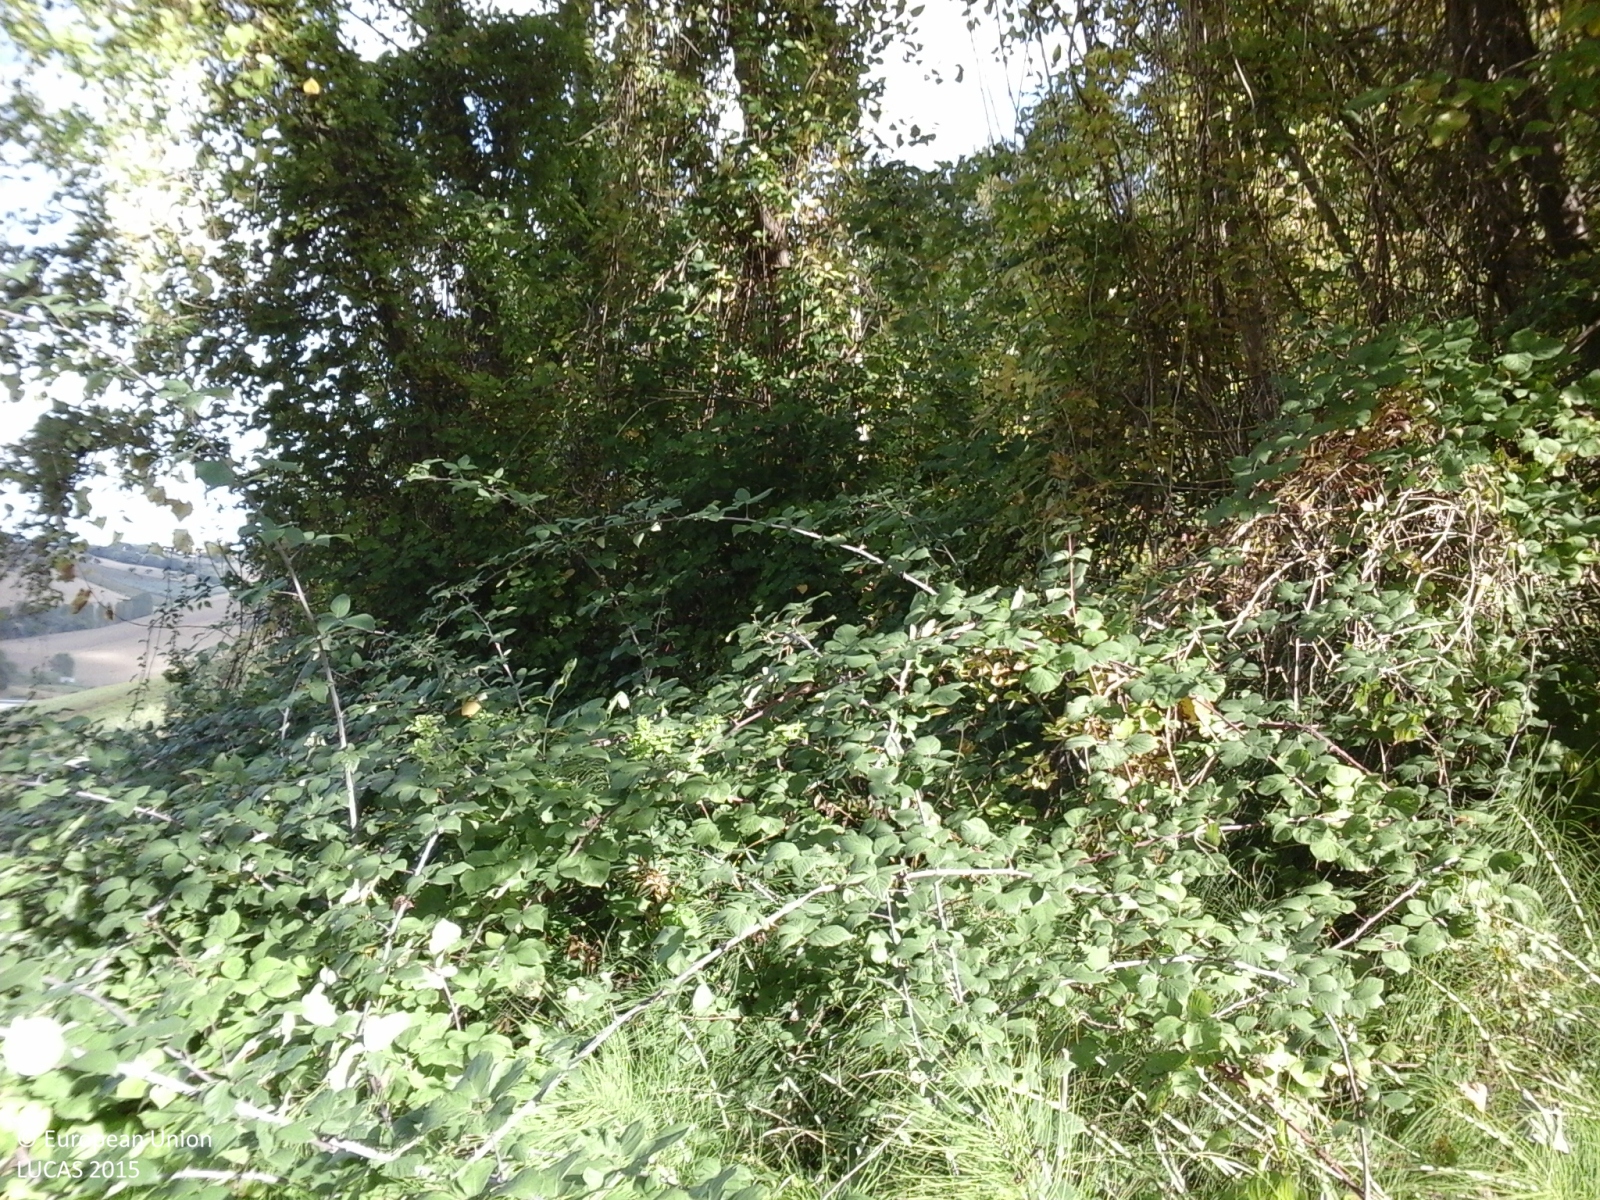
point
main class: Woodland
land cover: Broadleaved woodland
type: thermophilous deciduous forest
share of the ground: > 75 %
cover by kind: broadleaved forest trees 100 %
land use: Semi-natural and natural areas not in use
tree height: > 5 m
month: October
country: IT
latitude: 43.5522
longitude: 13.4699
